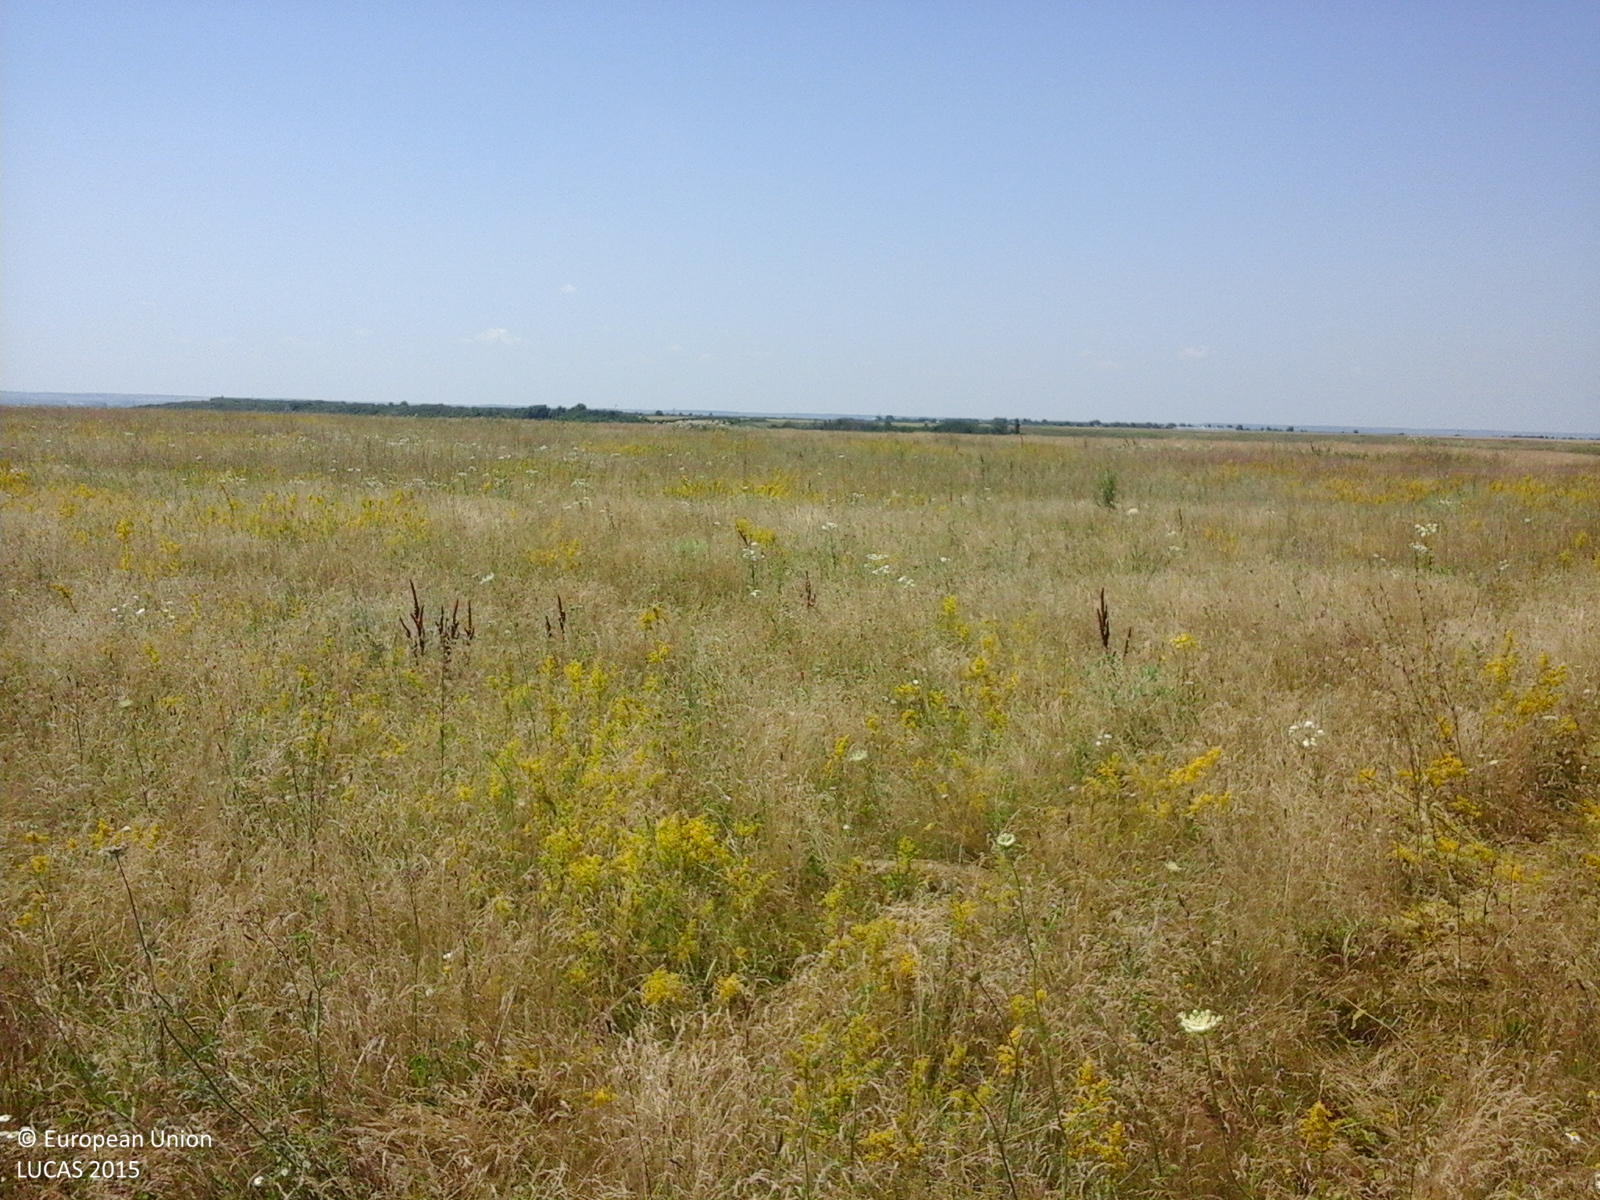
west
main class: Grassland
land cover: Spontaneously vegetated surfaces
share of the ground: > 75 %
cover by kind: herbaceous plants 100 %
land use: Fallow land
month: July
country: RO
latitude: 44.5148
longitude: 24.3724
